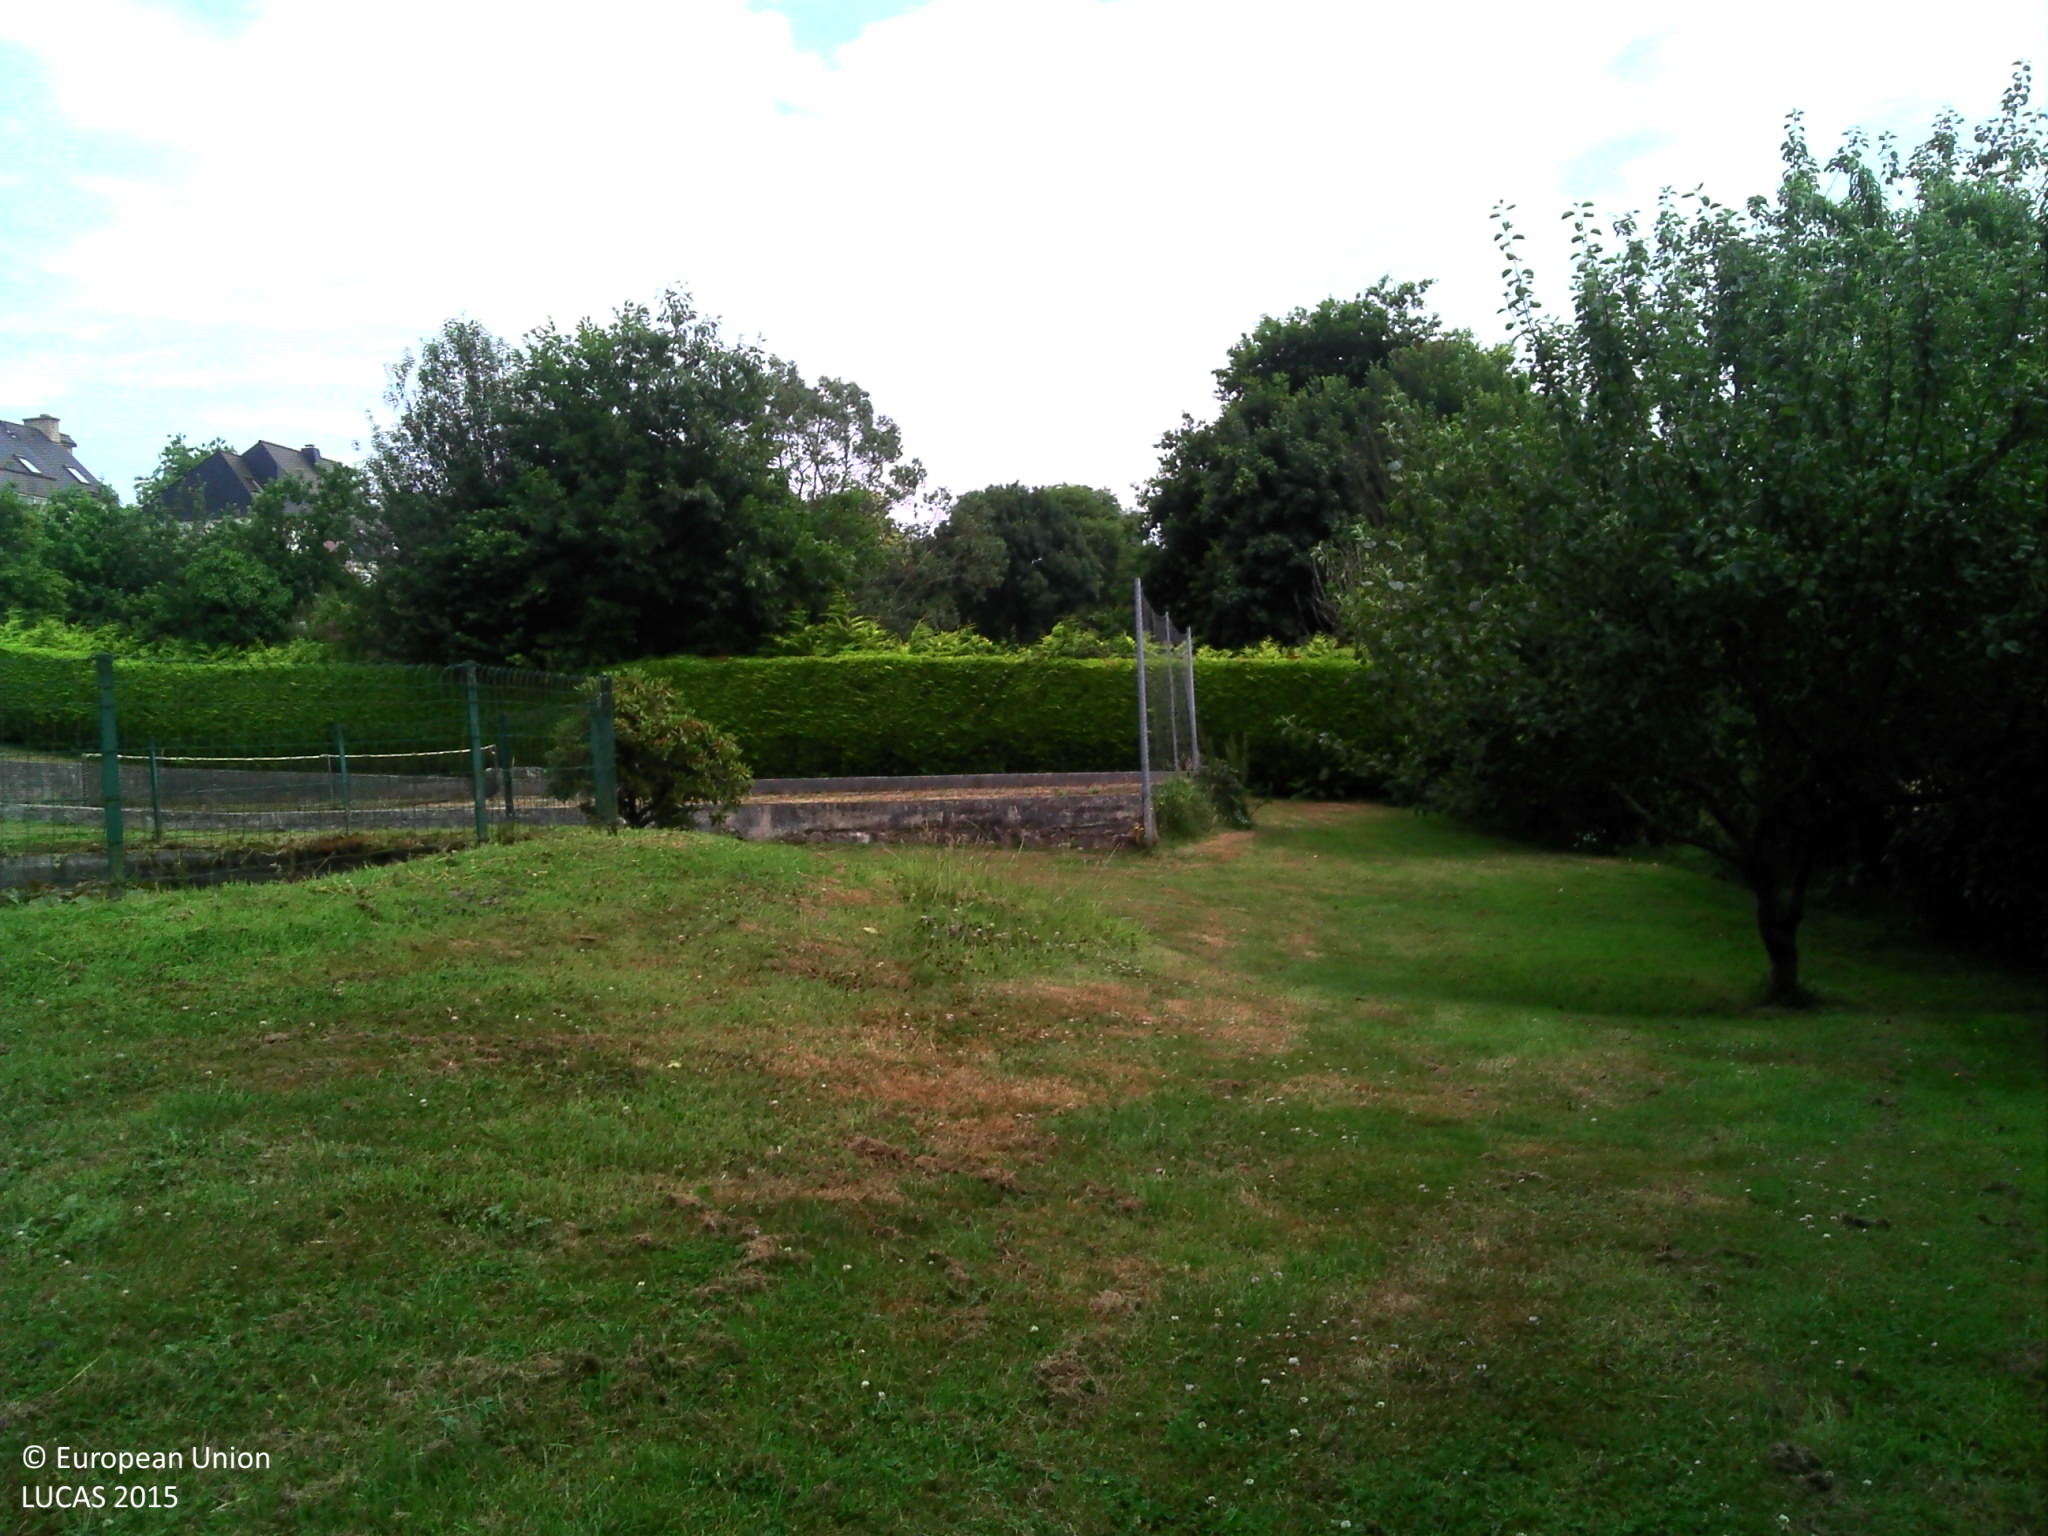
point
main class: Grassland
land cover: Spontaneously vegetated surfaces
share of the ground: > 75 %
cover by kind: herbaceous plants 100 %
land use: Semi-natural and natural areas not in use
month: July
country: FR
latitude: 48.7382
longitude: -3.5007
